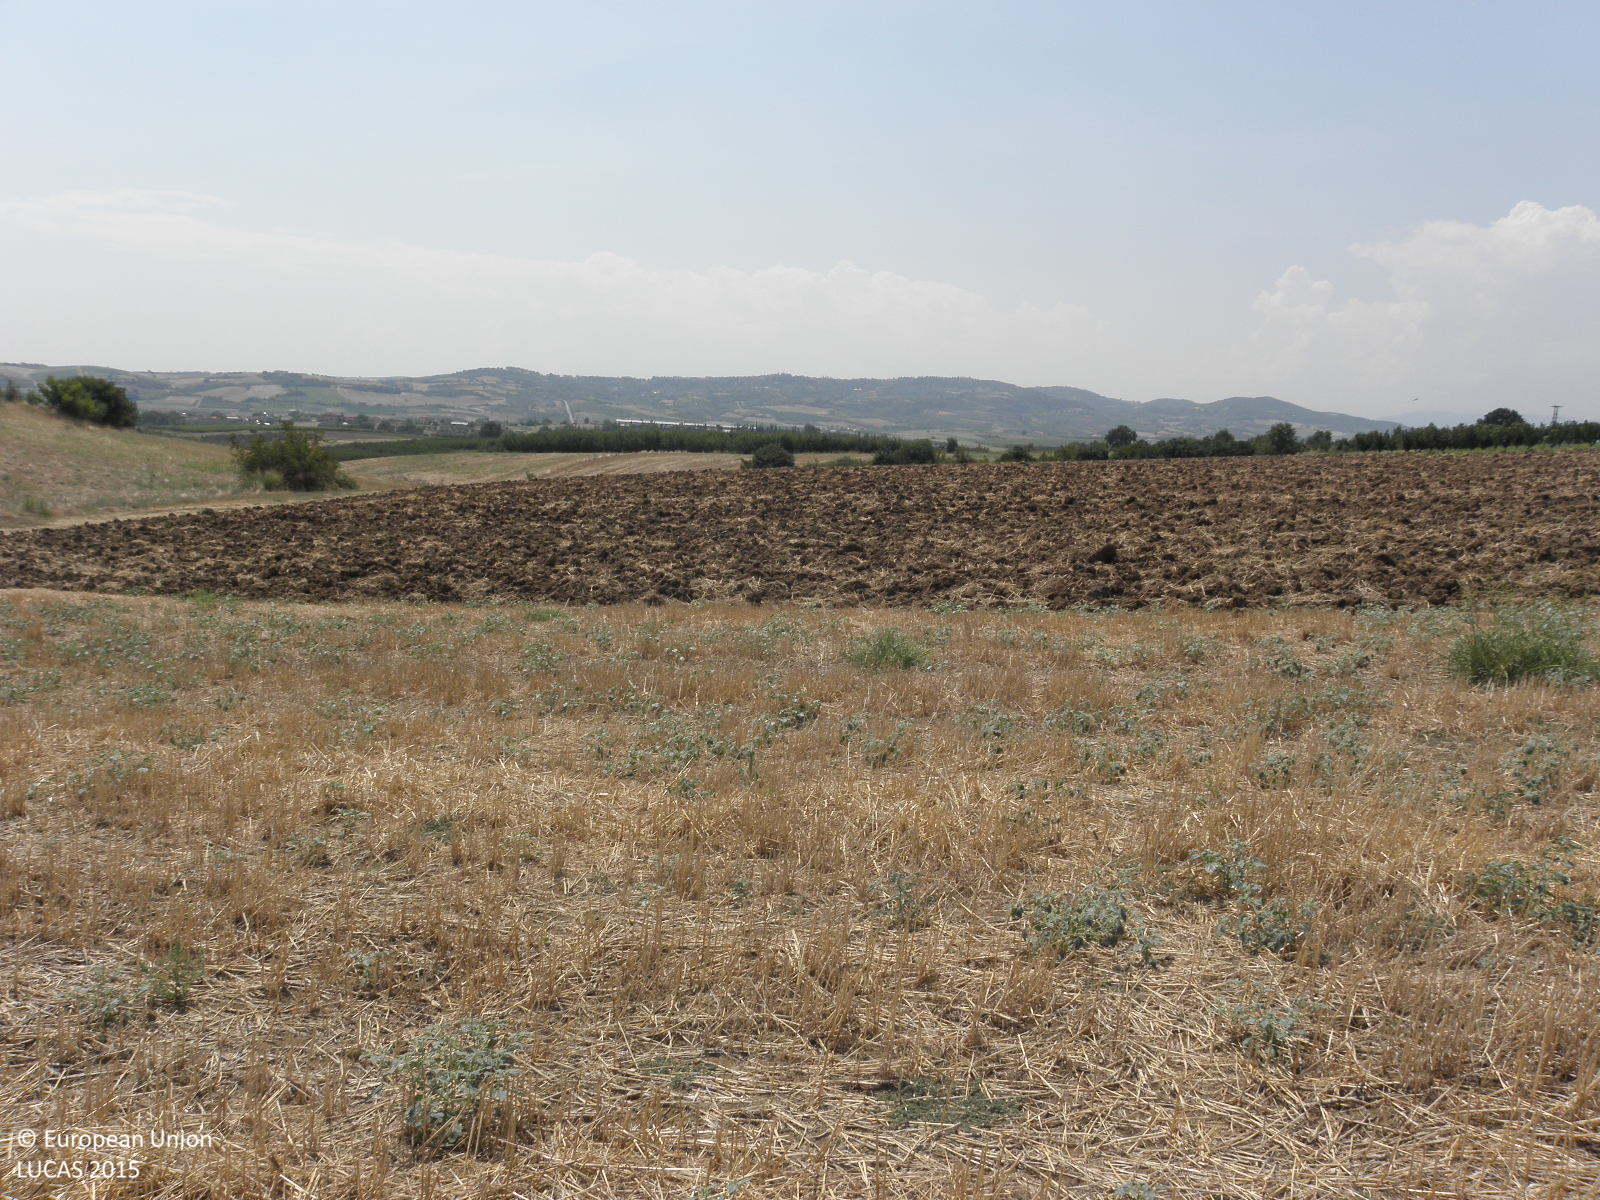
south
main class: Cropland
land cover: Durum wheat
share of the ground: > 75 %
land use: Agriculture (excluding fallow land and kitchen gardens)
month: August
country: GR
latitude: 40.5246
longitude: 22.5016
